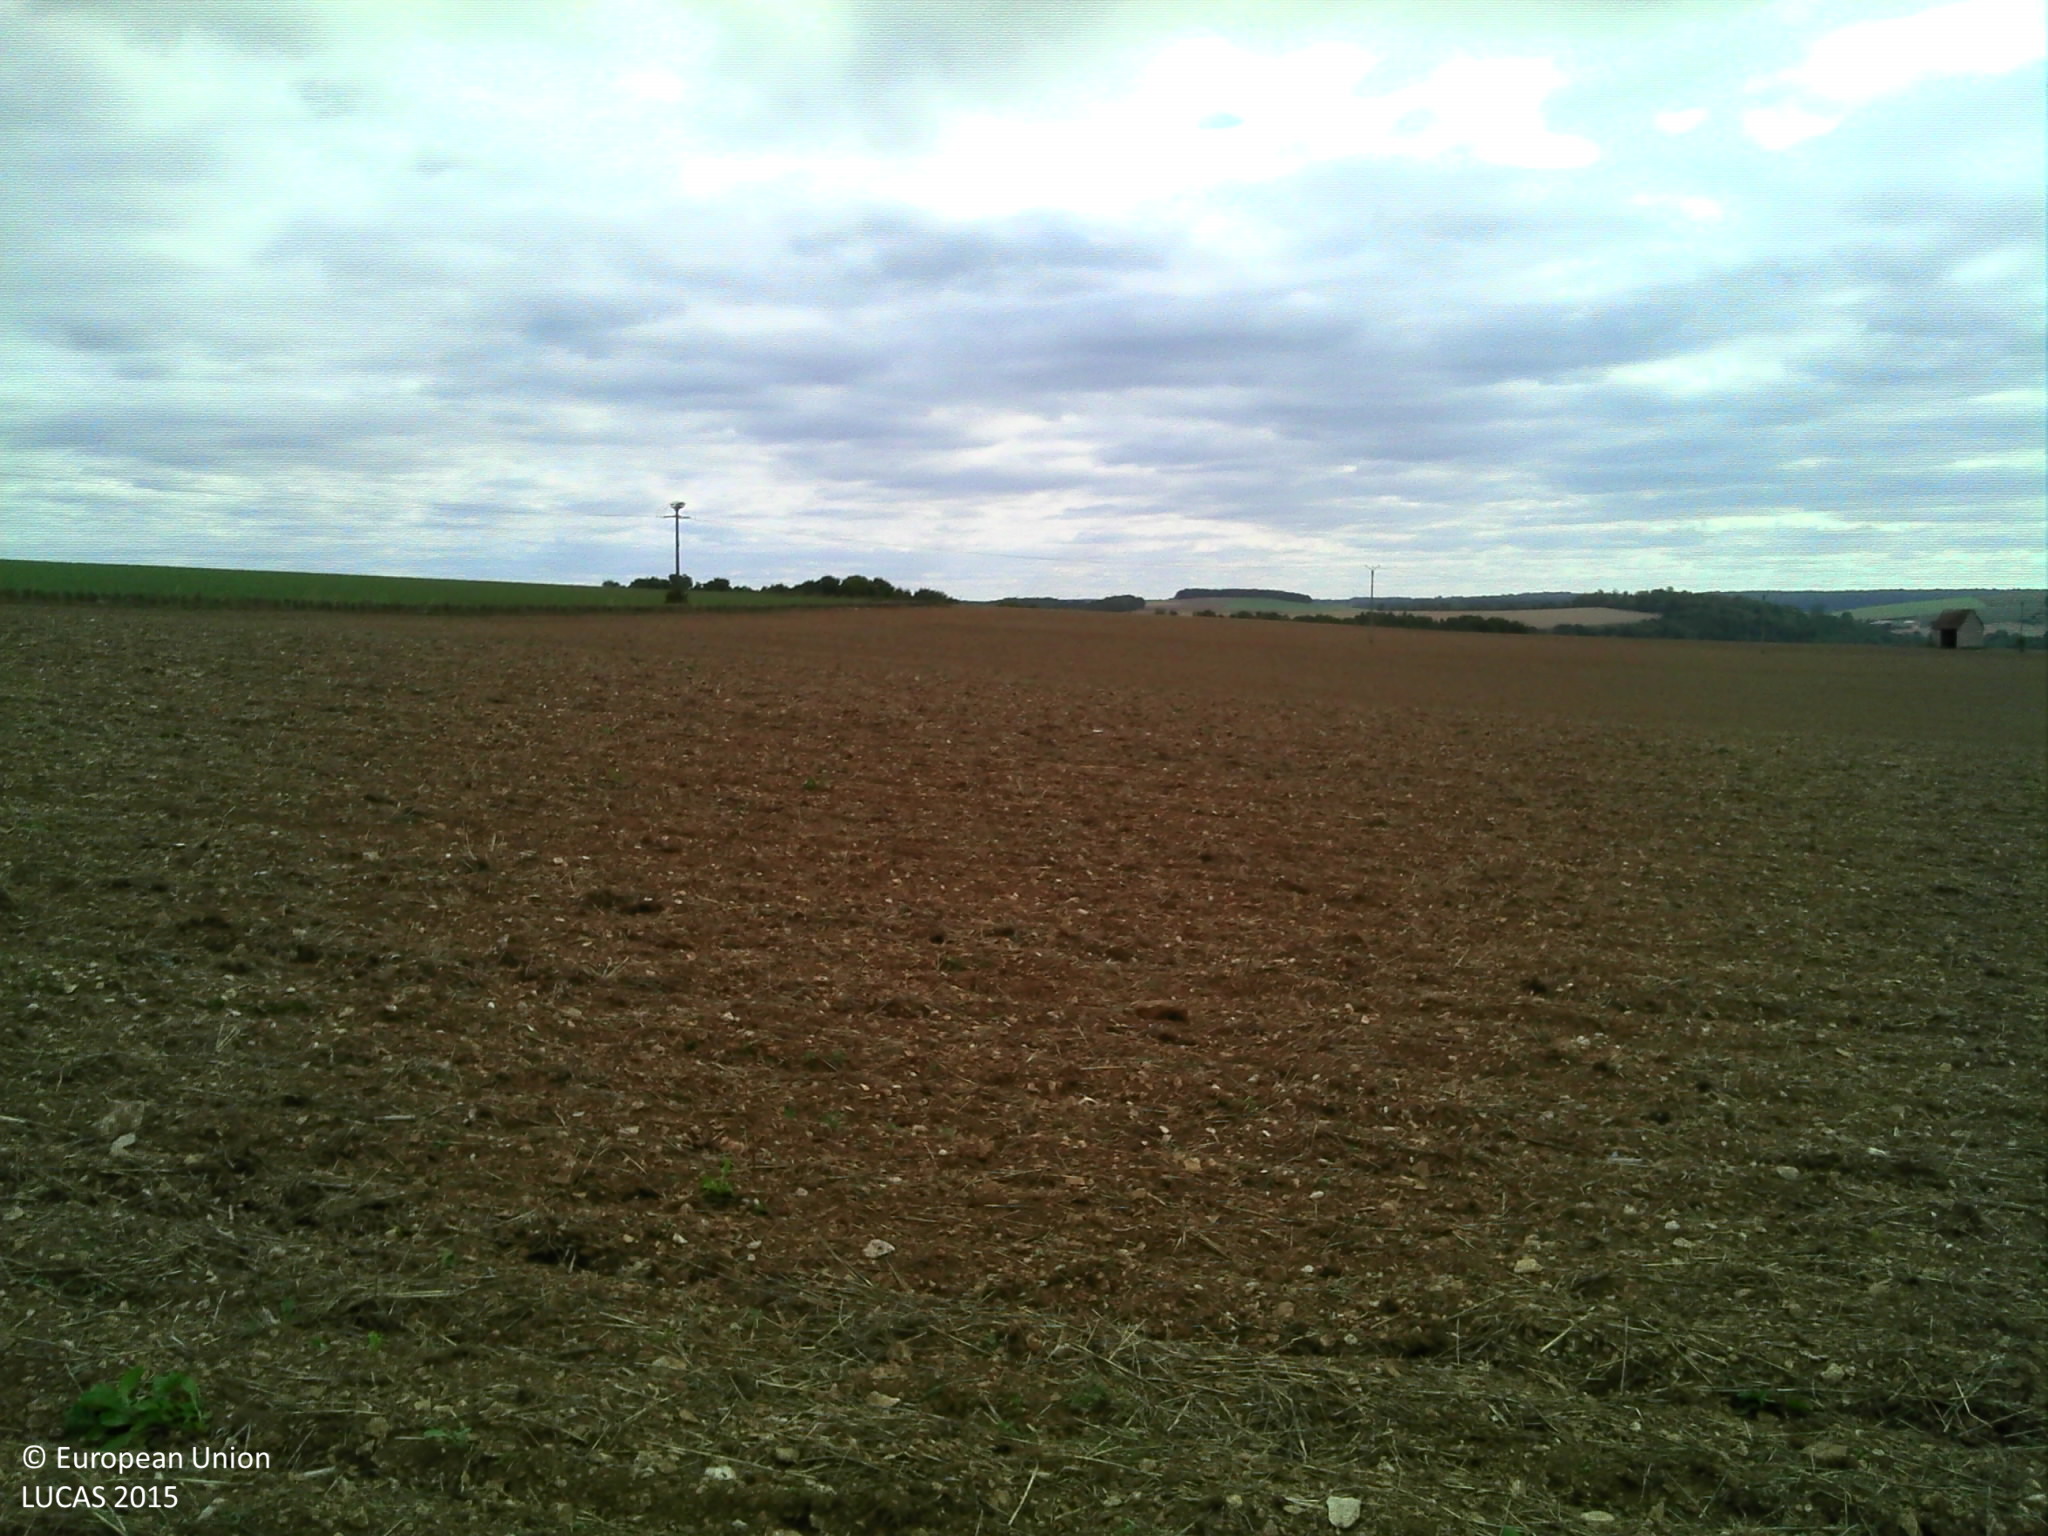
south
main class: Cropland
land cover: Common wheat
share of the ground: 10 - 25 %
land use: Agriculture (excluding fallow land and kitchen gardens)
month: September
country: FR
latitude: 47.5741
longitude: 4.7217
